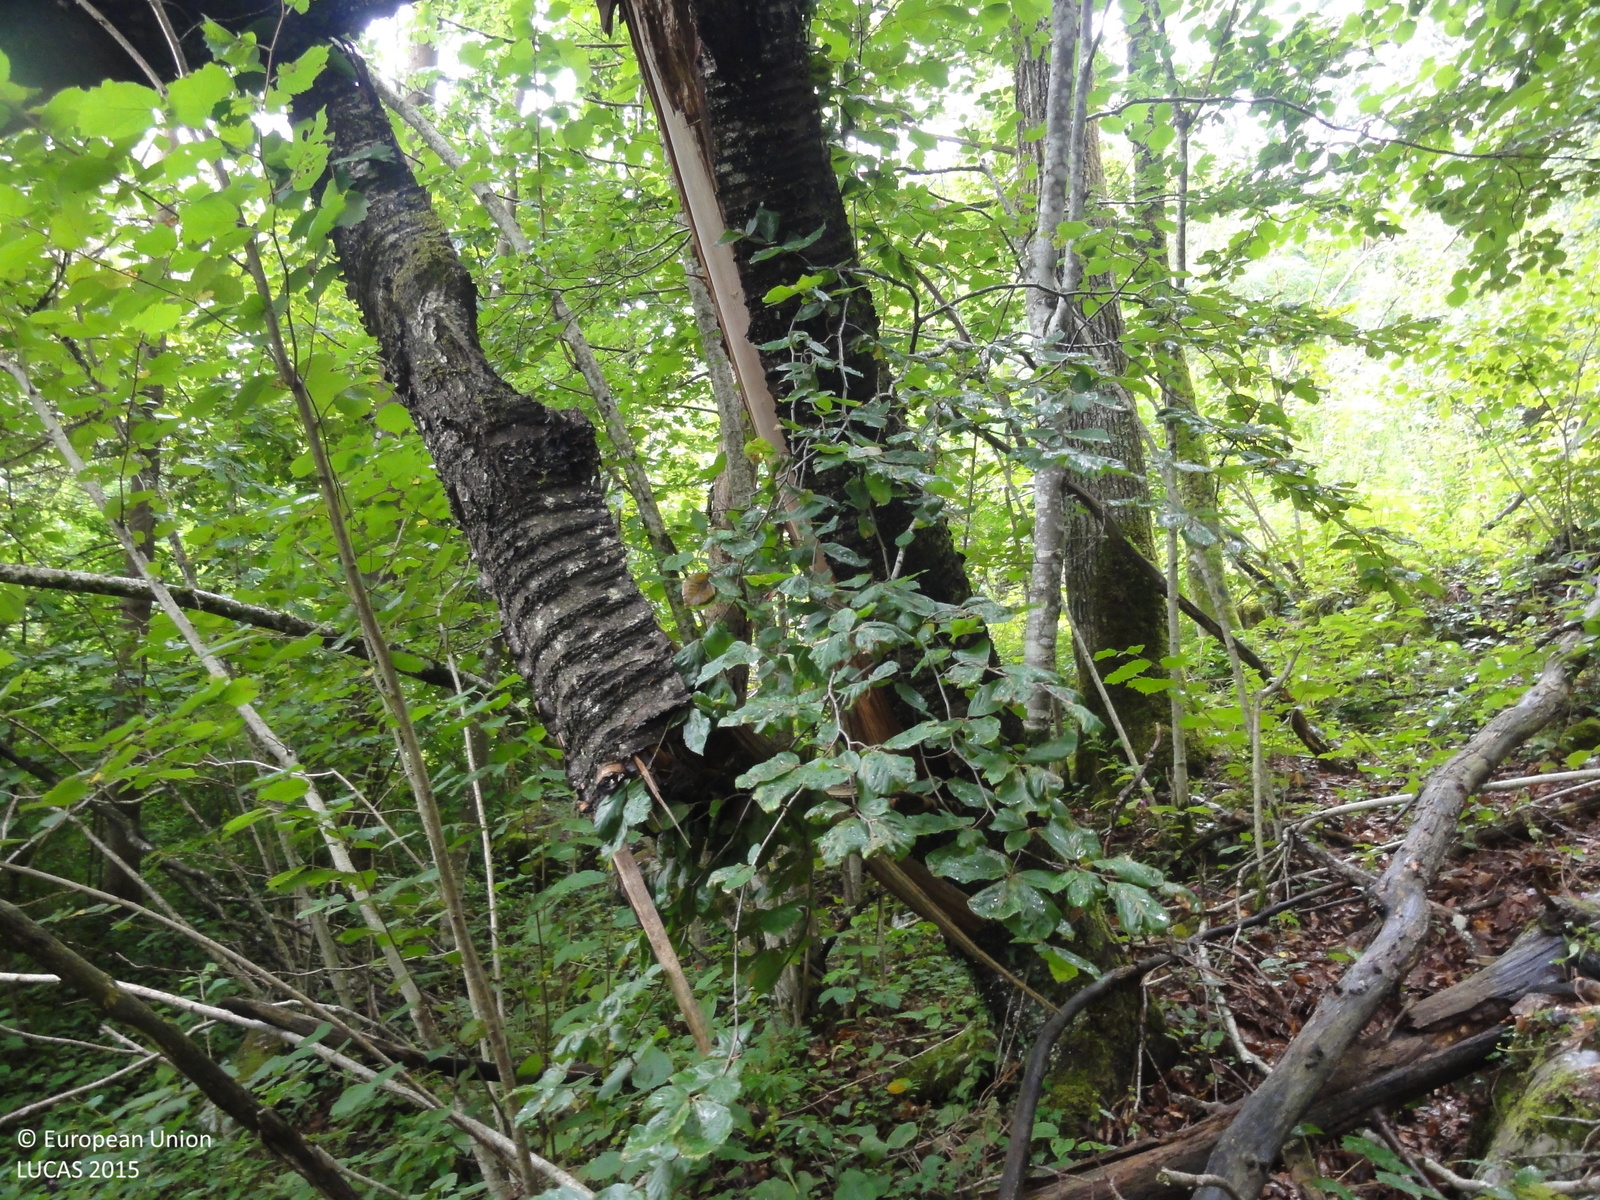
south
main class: Woodland
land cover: Spruce dominated mixed woodland
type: mountainous beech forest
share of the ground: > 75 %
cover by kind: broadleaved forest trees 55 %, coniferous forest trees 35 %, shrubs 10 %
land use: Forestry
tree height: > 5 m
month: July
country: SI
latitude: 45.7758
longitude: 14.7674
